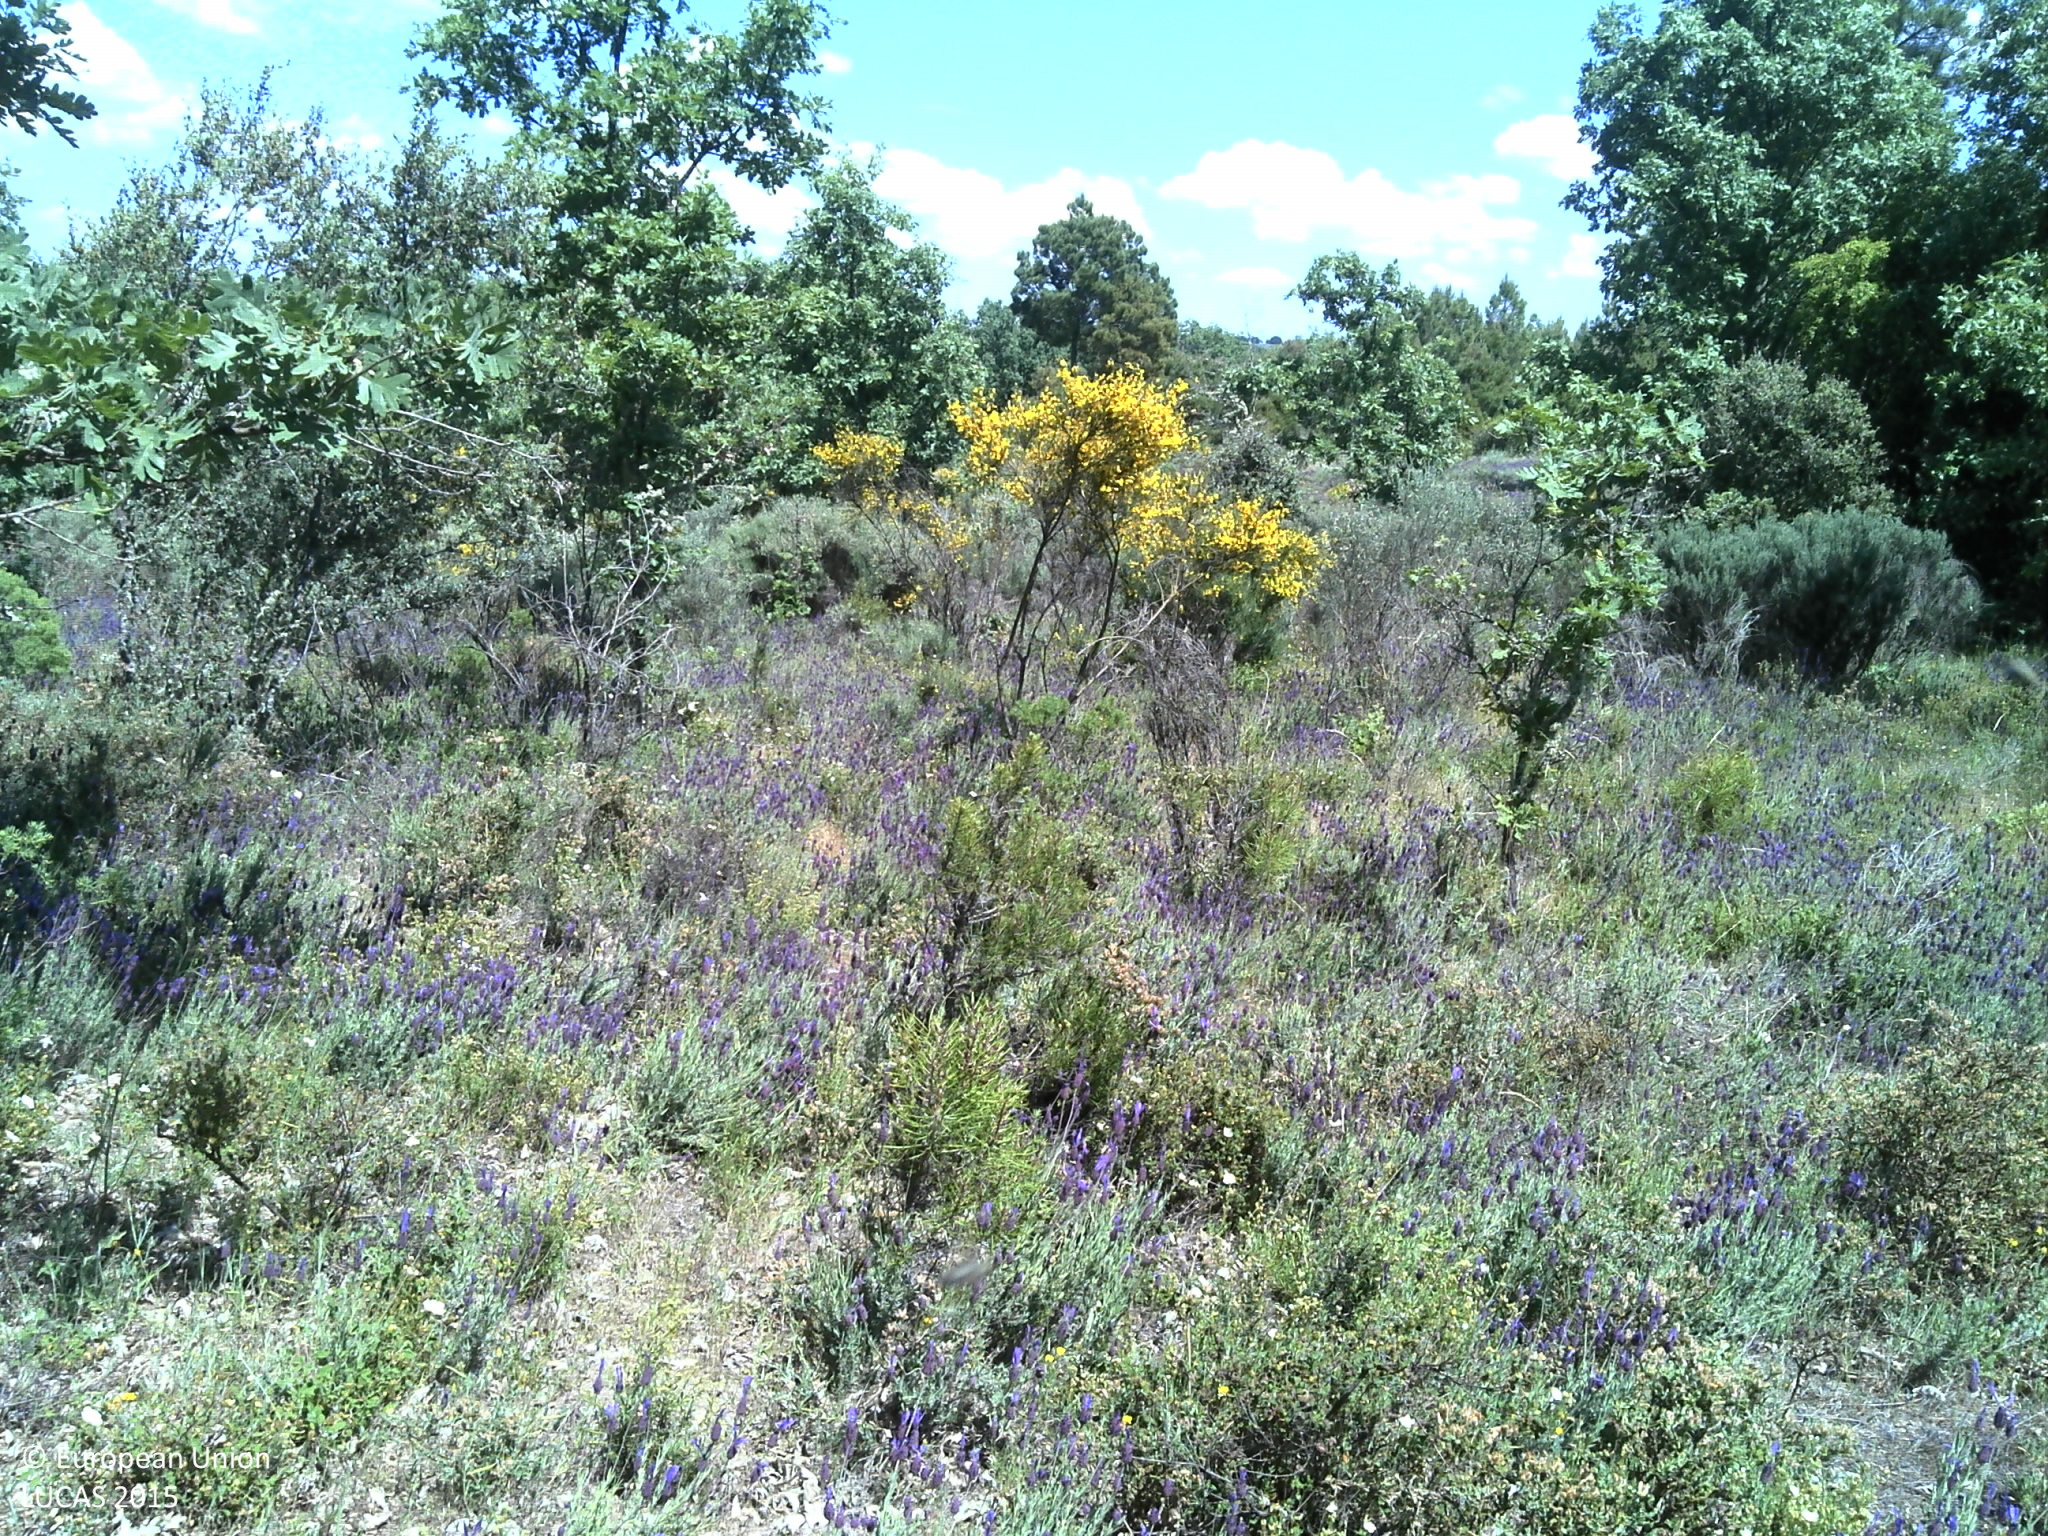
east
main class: Shrubland
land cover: Shrubland with sparse tree cover
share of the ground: > 75 %
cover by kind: shrubs 80 %, herbaceous plants 10 %, broadleaved forest trees 5 %, unconsolidated bare surface 5 %
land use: Forestry
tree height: > 5 m
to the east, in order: Shrubland with sparse tree cover; Broadleaved woodland; Shrubland with sparse tree cover; Shrubland without tree cover; Shrubland with sparse tree cover; Shrubland without tree cover; Broadleaved woodland; Dry stone walls; Lines of trees; Pine dominated coniferous woodland; Shruby margins; Shrubland with sparse tree cover; Broadleaved woodland; Dry stone walls; Broadleaved woodland
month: May
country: PT
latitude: 41.5860
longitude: -6.3789
